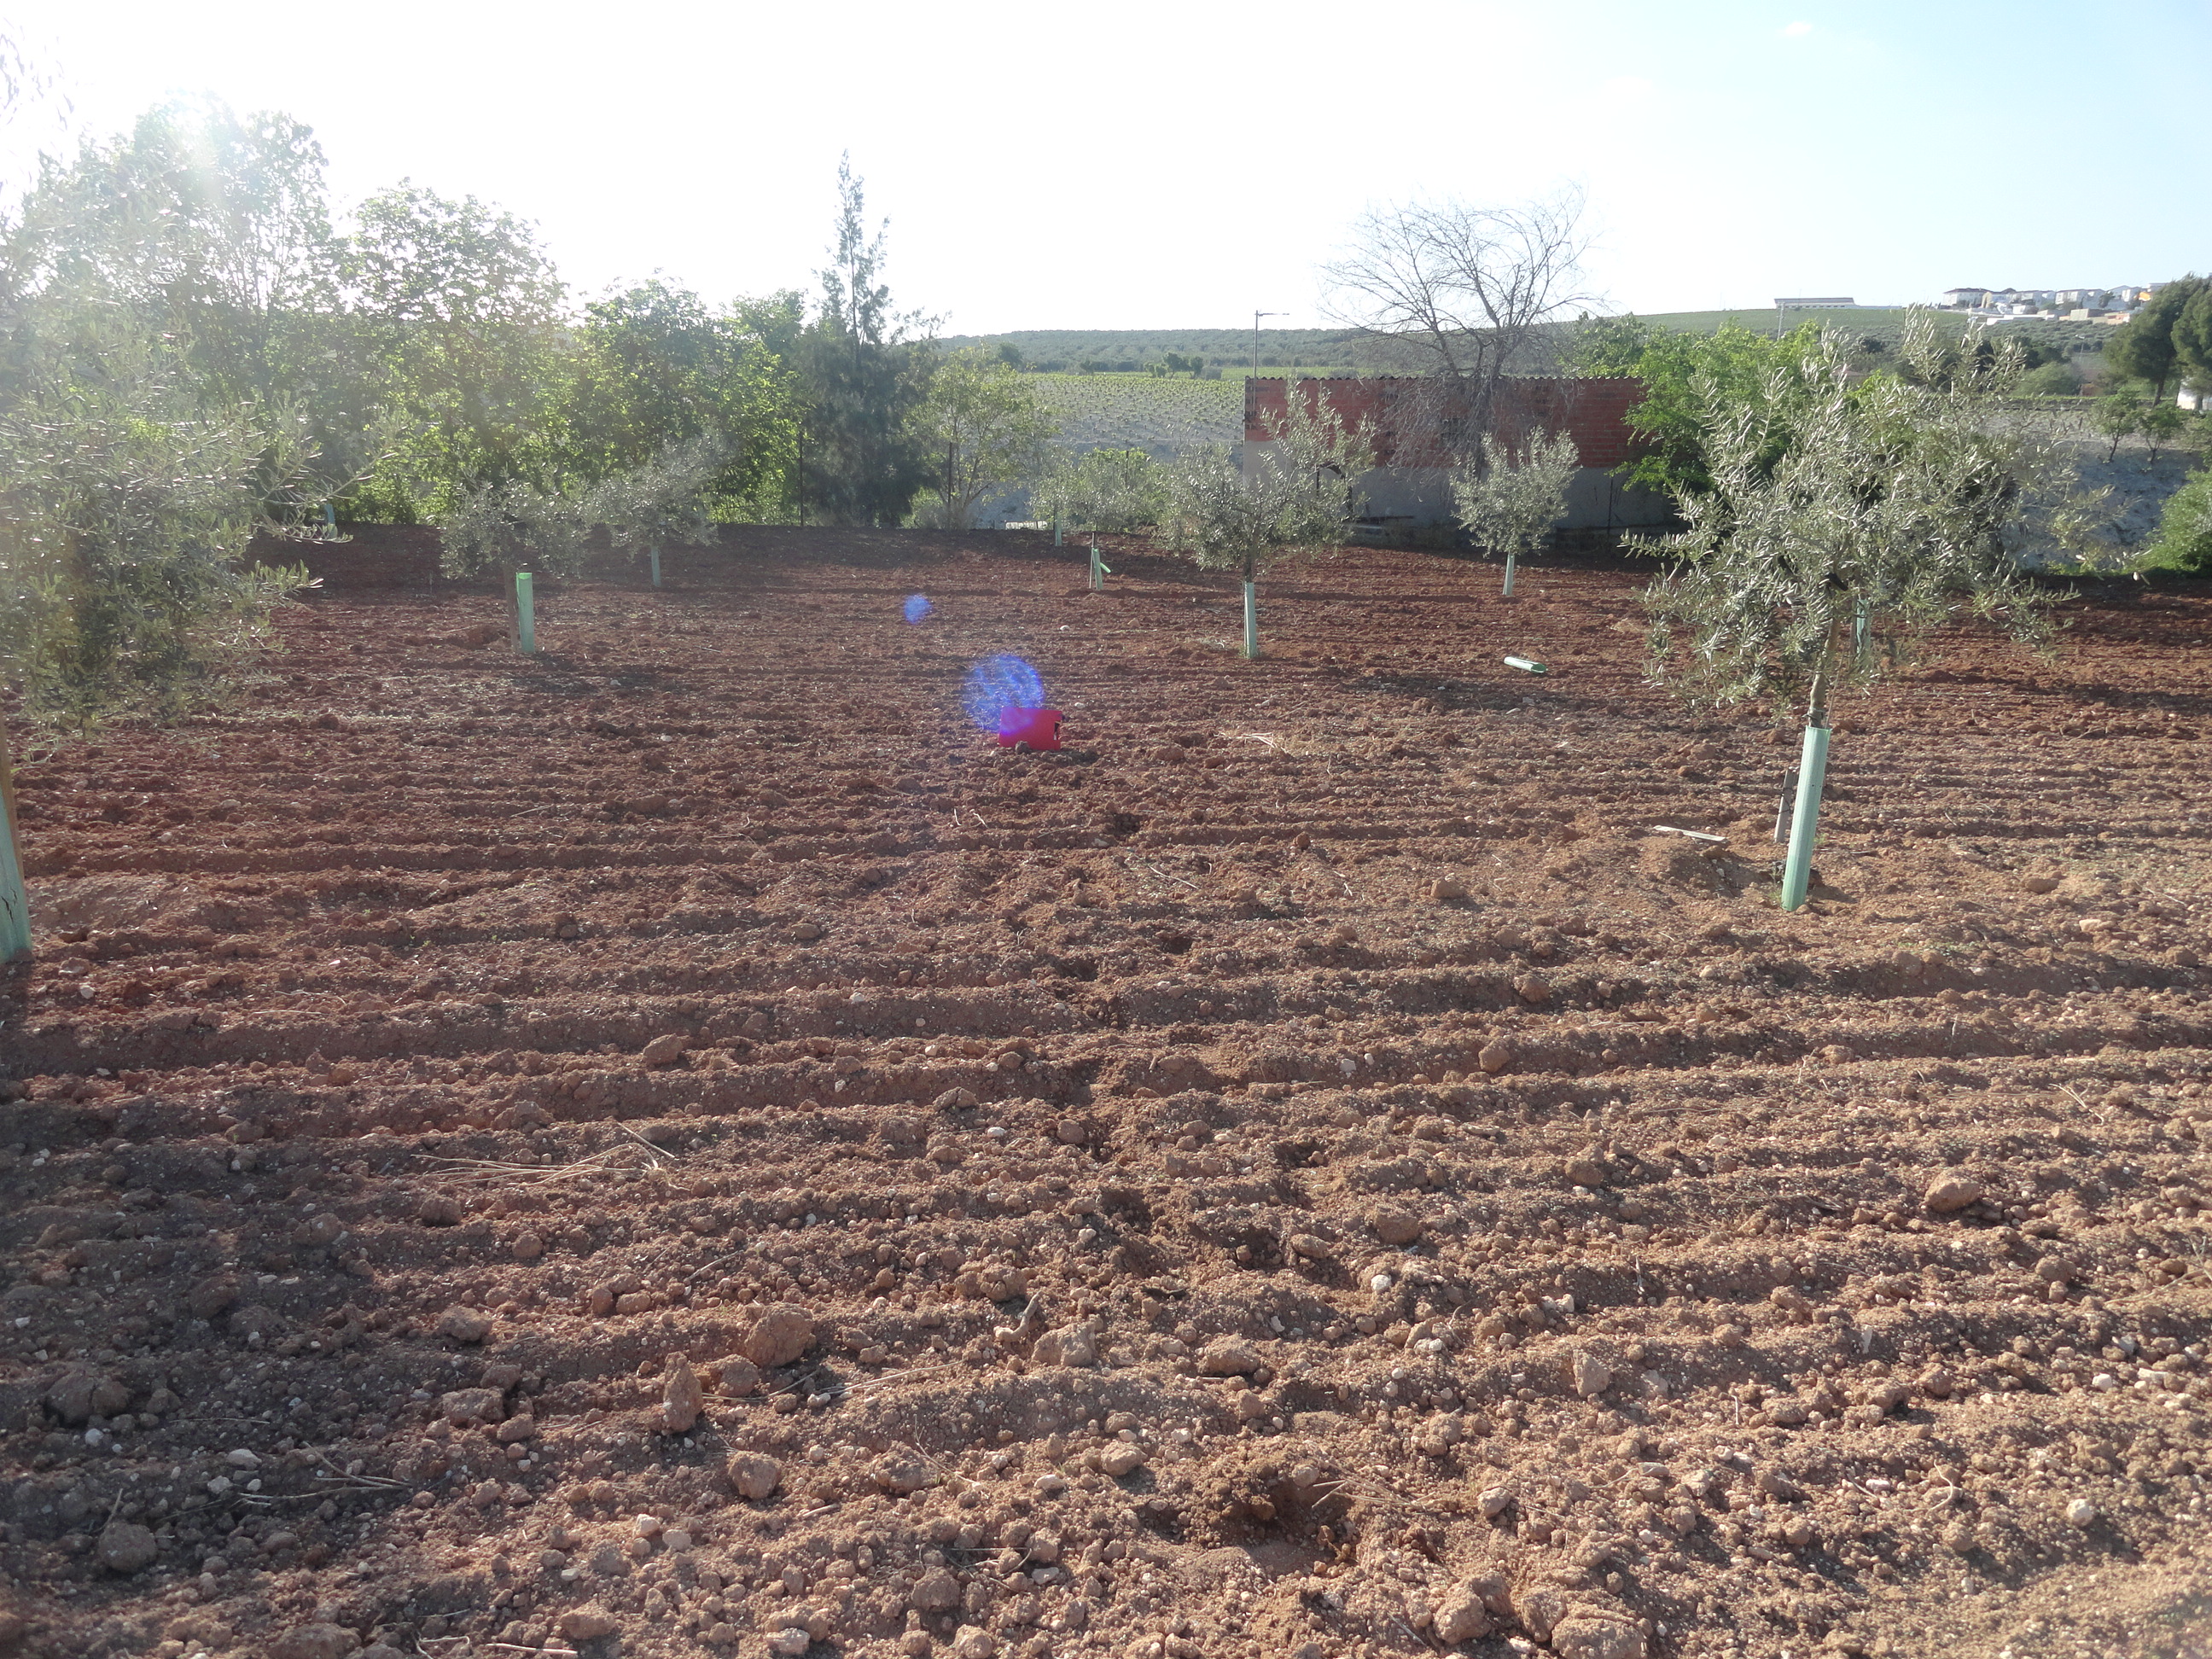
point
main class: Cropland
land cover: Olive groves
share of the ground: 10 - 25 %
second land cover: Other bare soil
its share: > 75 %
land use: Agriculture (excluding fallow land and kitchen gardens)
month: April
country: ES
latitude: 37.4635
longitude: -4.5781
